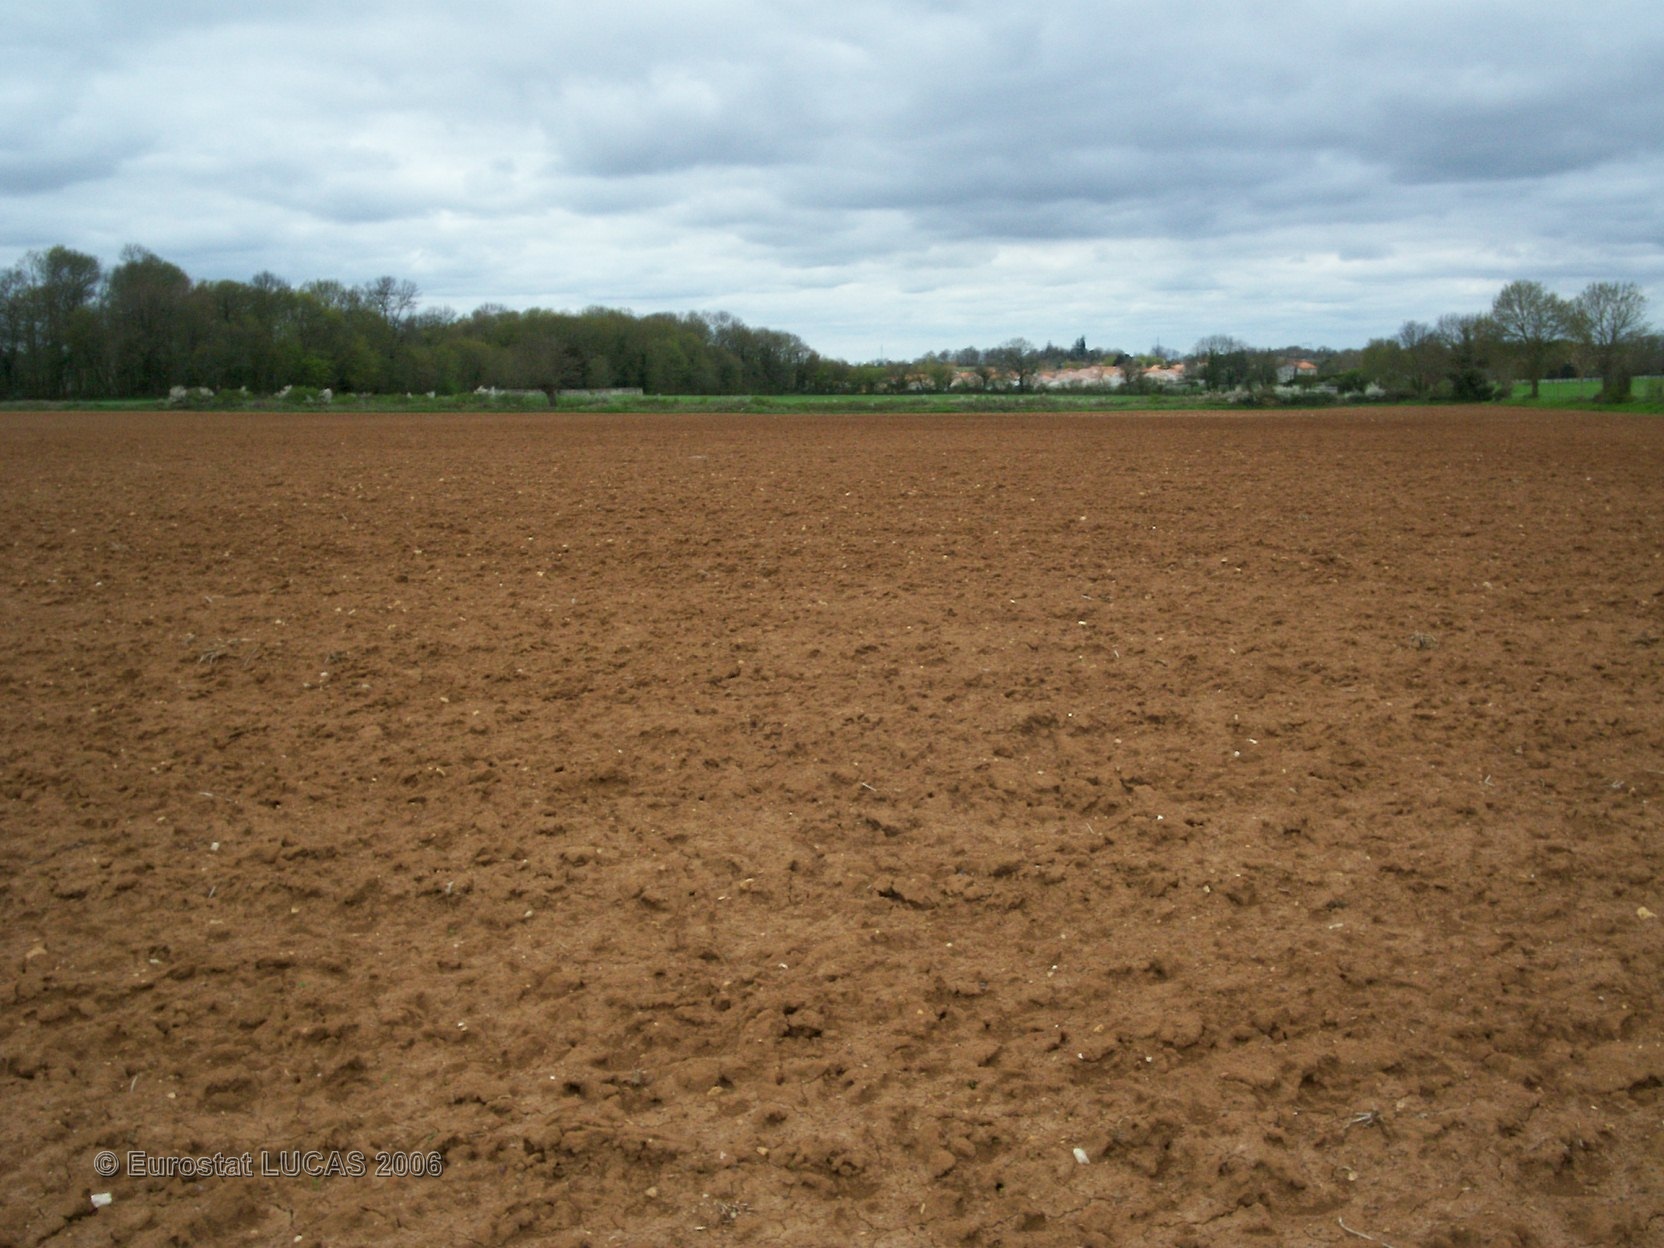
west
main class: Cropland
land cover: Maize
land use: Agriculture (excluding fallow land and kitchen gardens)
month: May
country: FR
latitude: 46.2916
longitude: -0.2651
